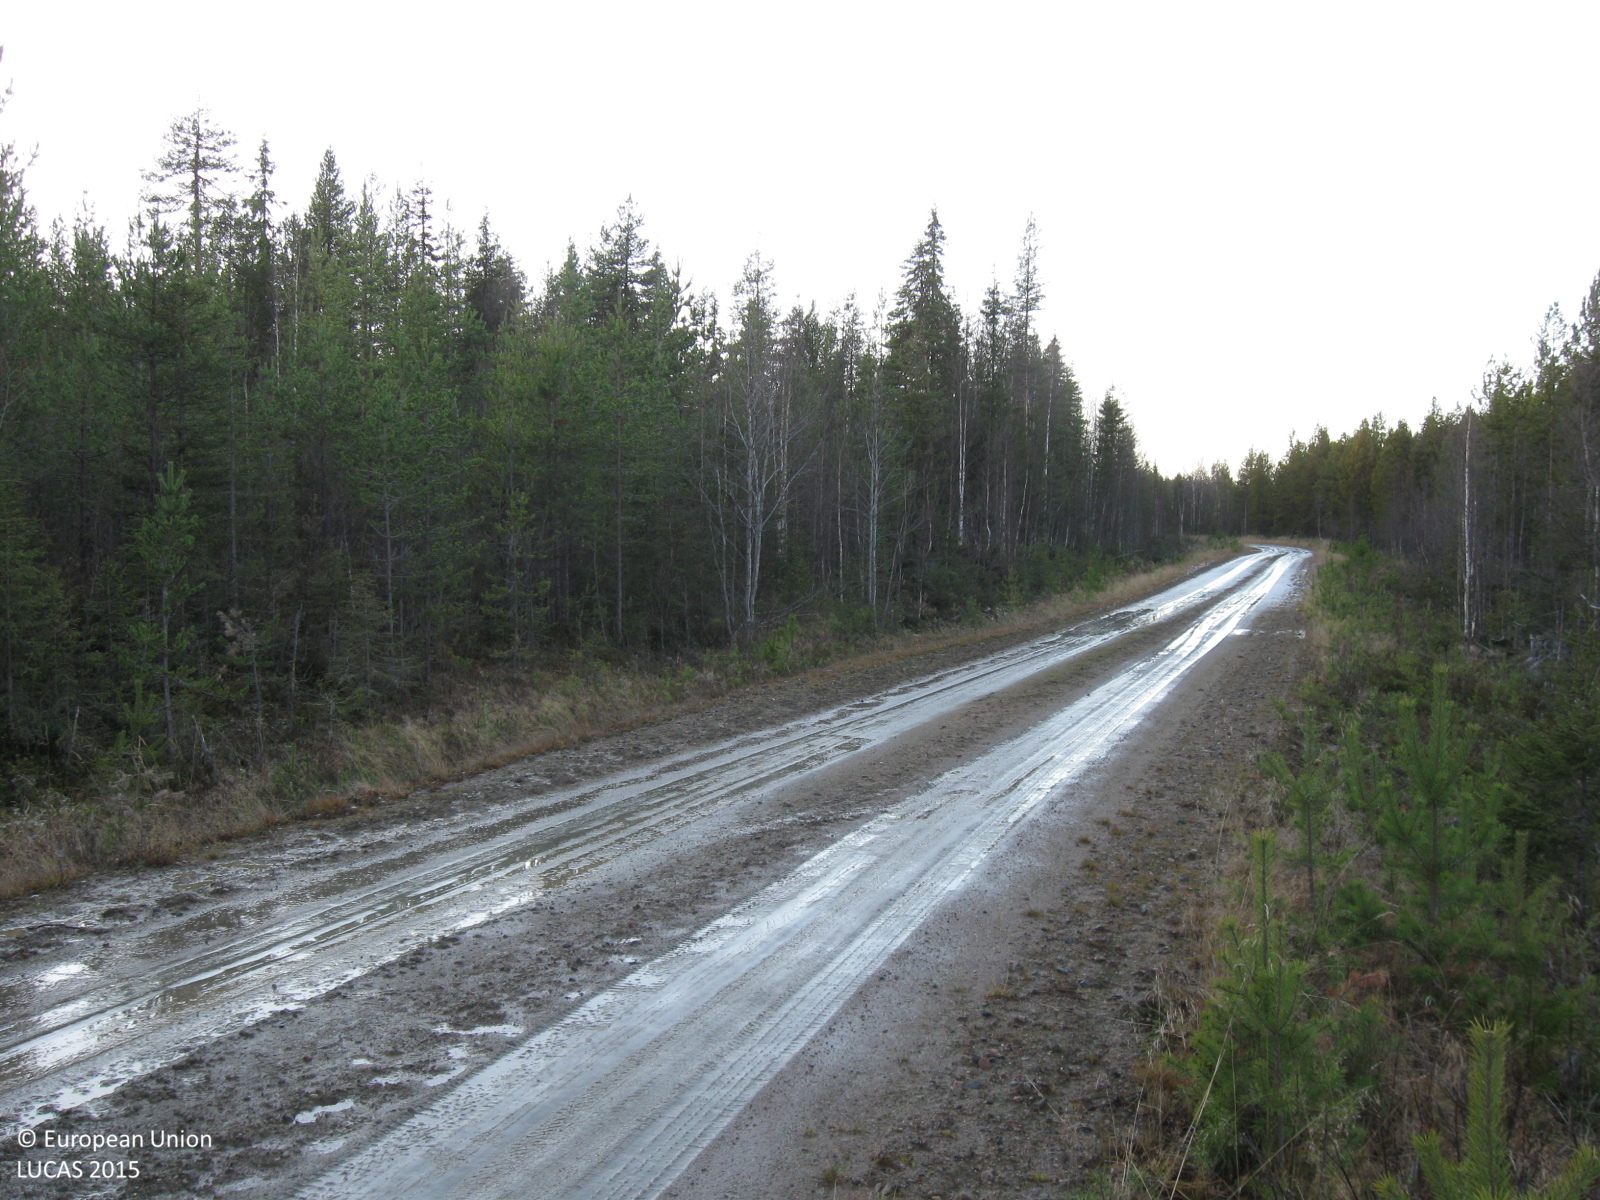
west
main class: Woodland
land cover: Other mixed woodland
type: boreal forest
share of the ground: > 75 %
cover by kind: coniferous forest trees 60 %, broadleaved forest trees 20 %, shrubs 10 %, herbaceous plants 10 %
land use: Forestry
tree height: > 5 m
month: November
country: SE
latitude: 66.1985
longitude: 20.5968
